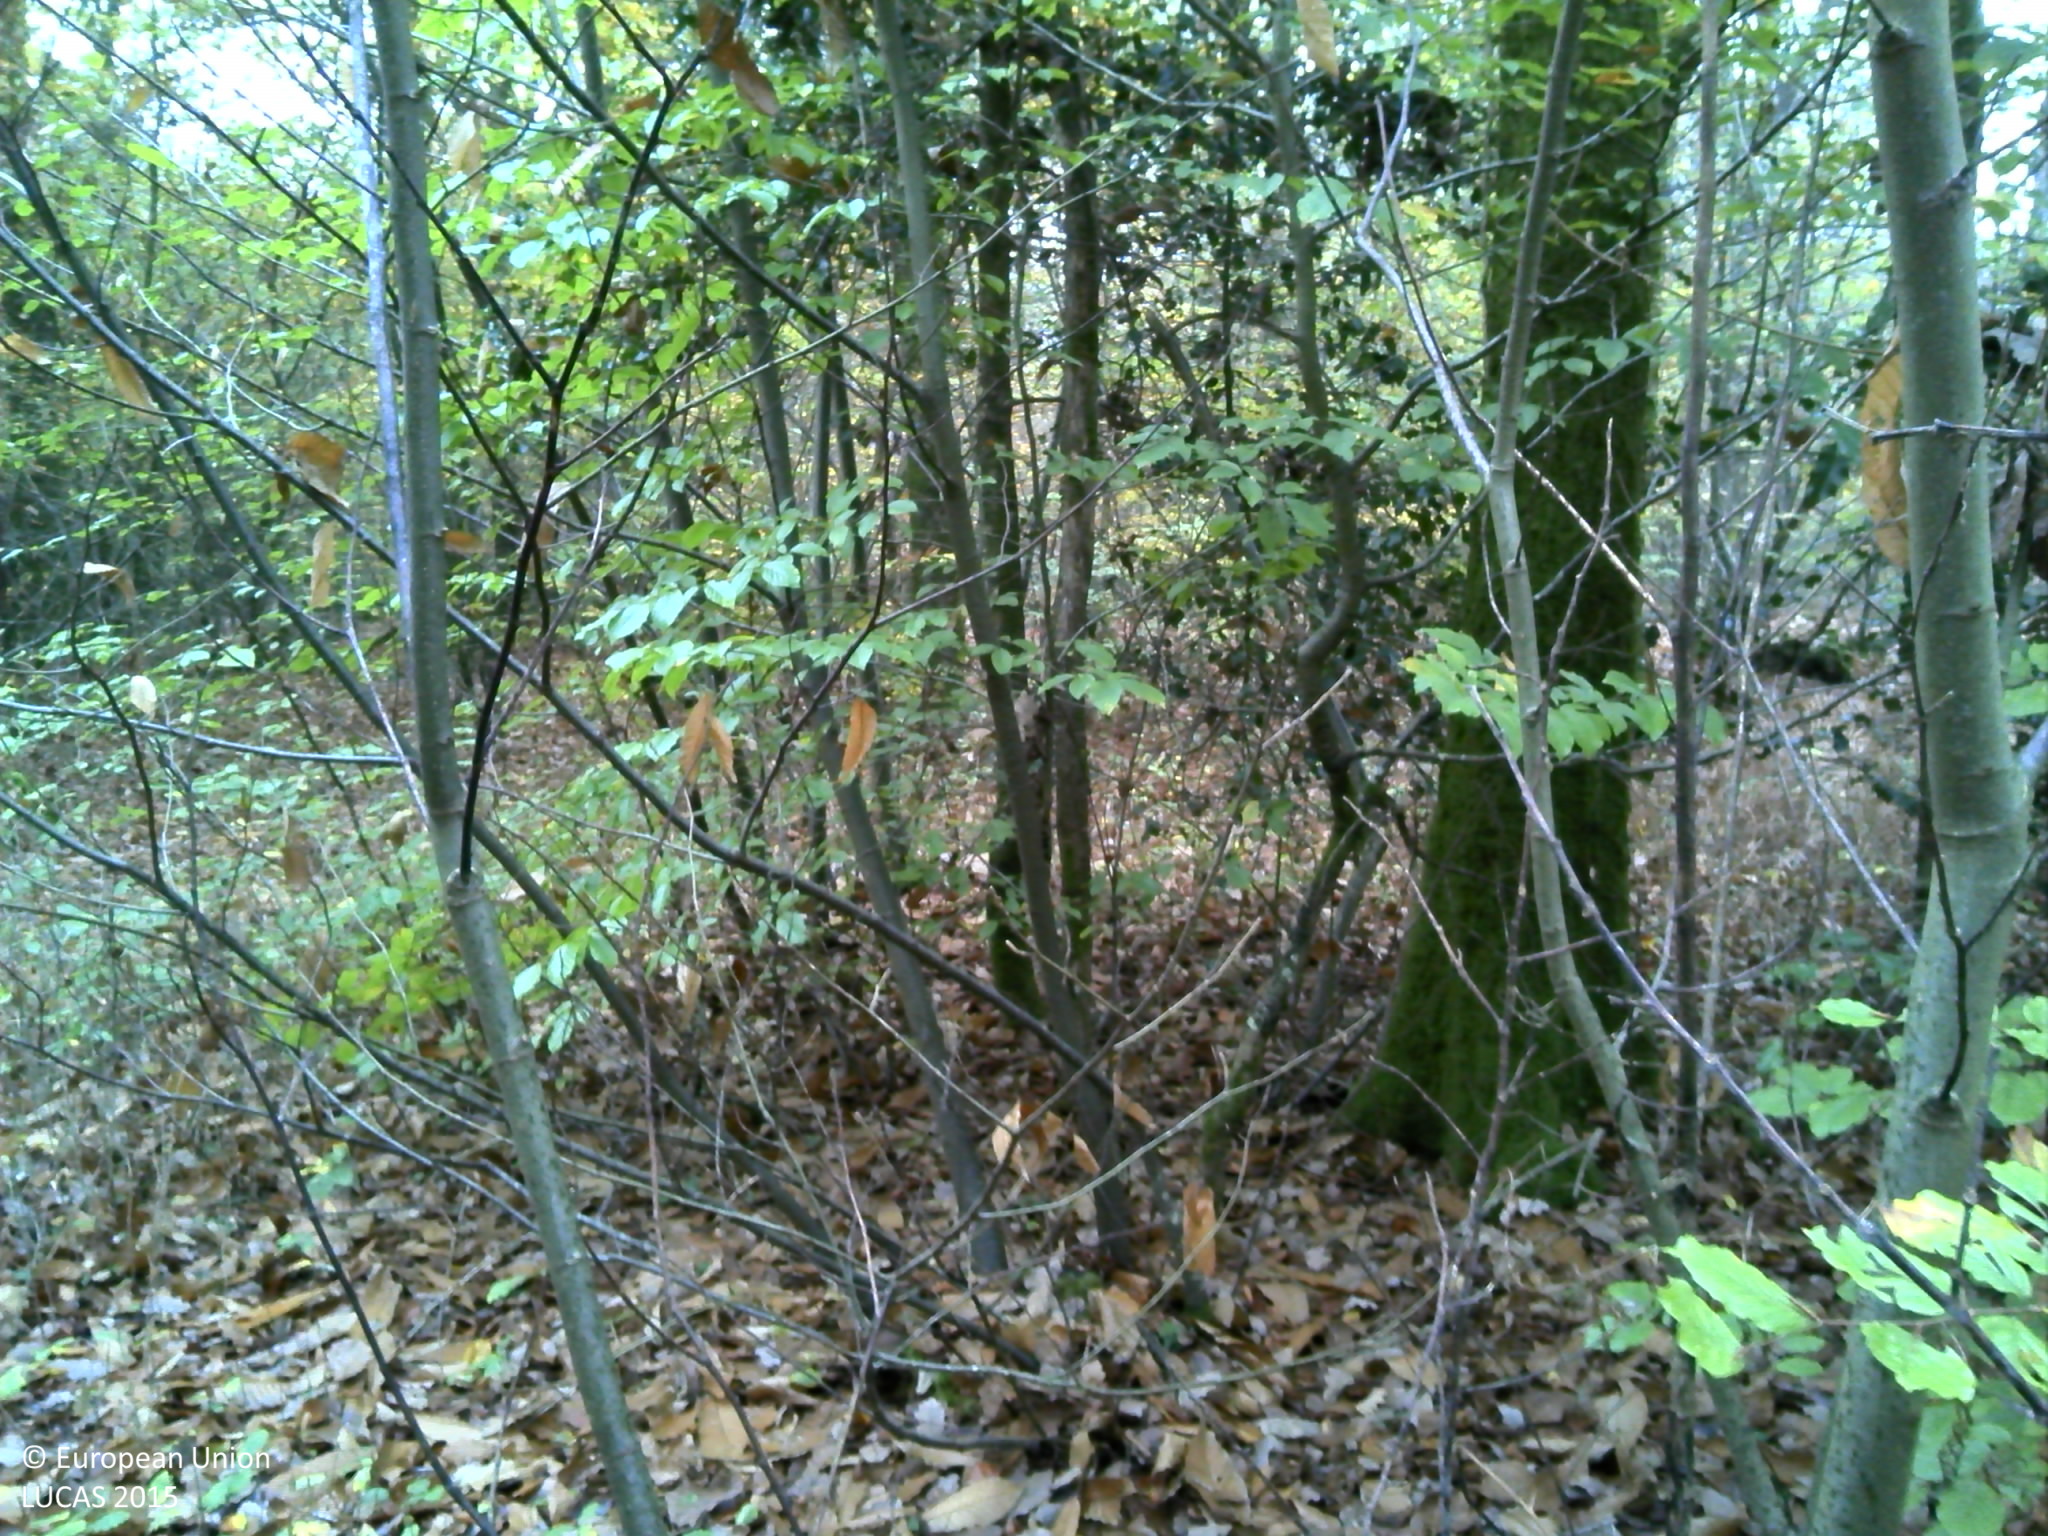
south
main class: Woodland
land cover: Broadleaved woodland
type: acidophilous oak and oak-birch forest
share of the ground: > 75 %
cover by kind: broadleaved forest trees 85 %, herbaceous plants 10 %, lichens and mosses 5 %
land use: Forestry
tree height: > 5 m
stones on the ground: < 10 %
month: November
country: FR
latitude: 47.5474
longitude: -1.3215
